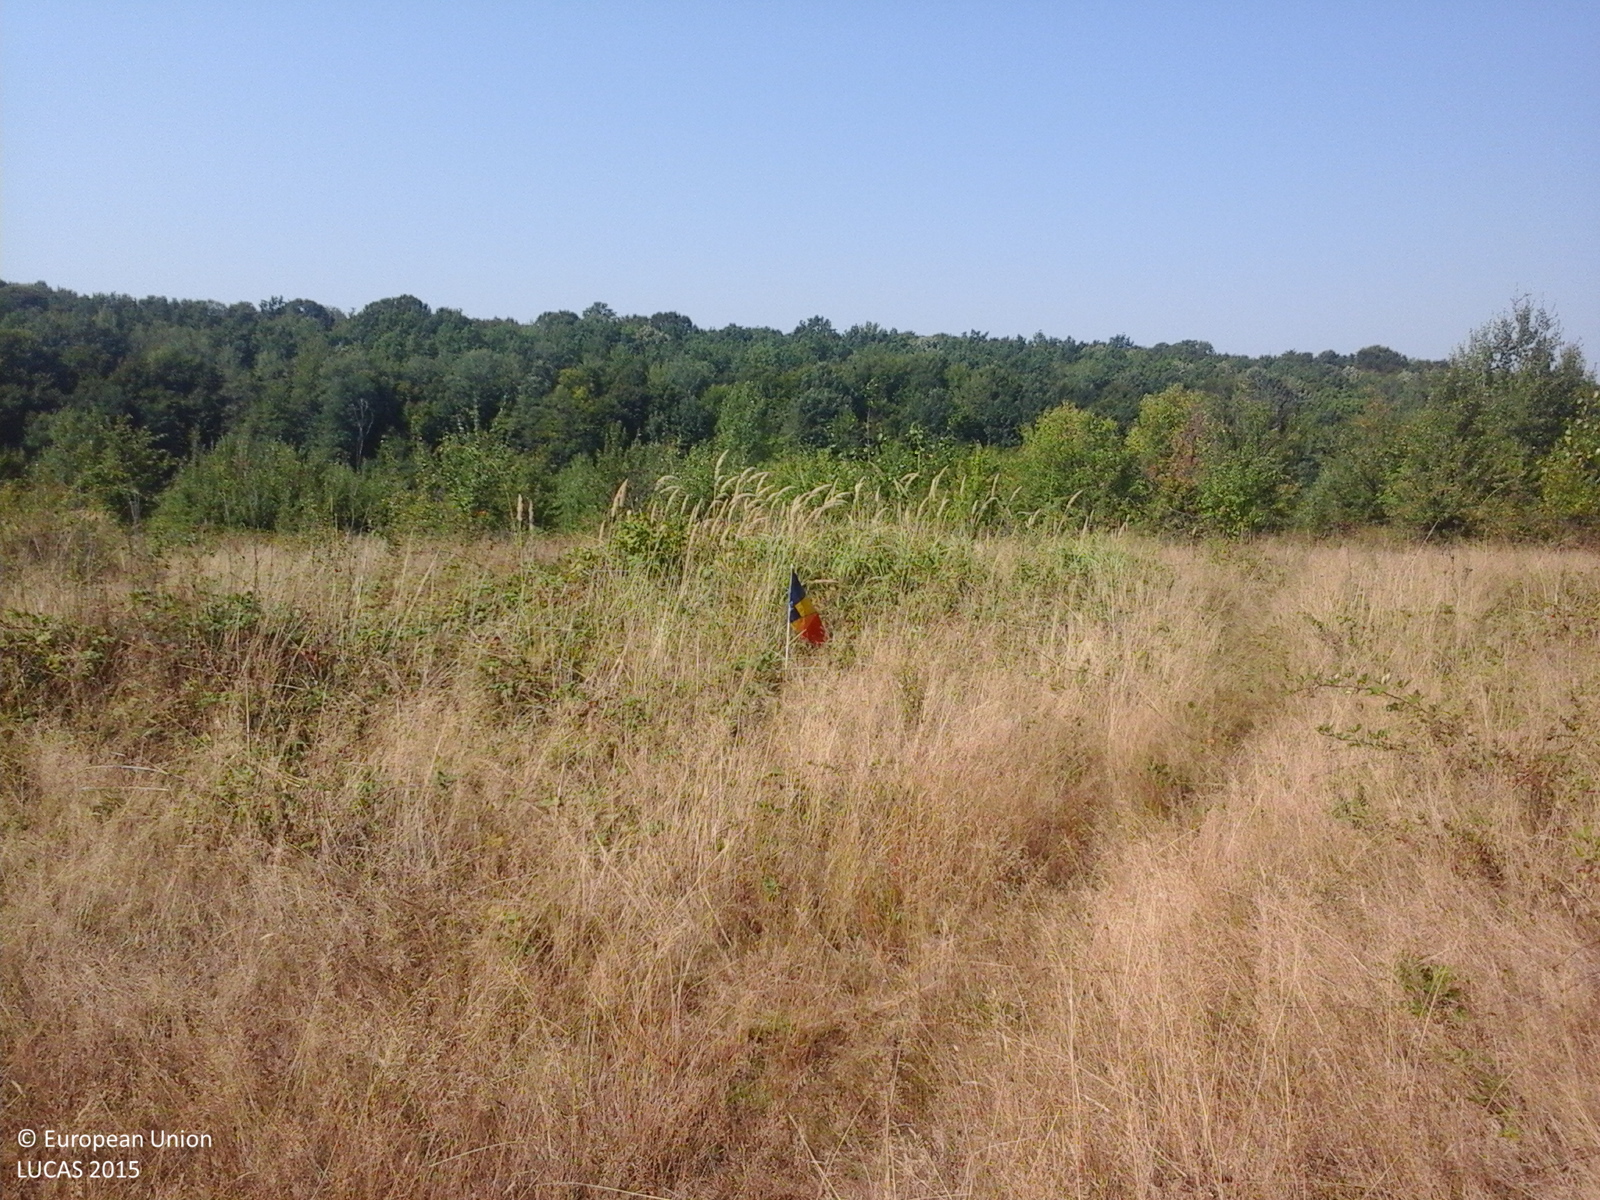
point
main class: Grassland
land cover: Grassland with sparse tree/shrub cover
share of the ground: > 75 %
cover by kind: herbaceous plants 85 %, shrubs 10 %, broadleaved forest trees 5 %
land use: Fallow land
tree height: < 5 m
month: August
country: RO
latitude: 46.3926
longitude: 22.2324
